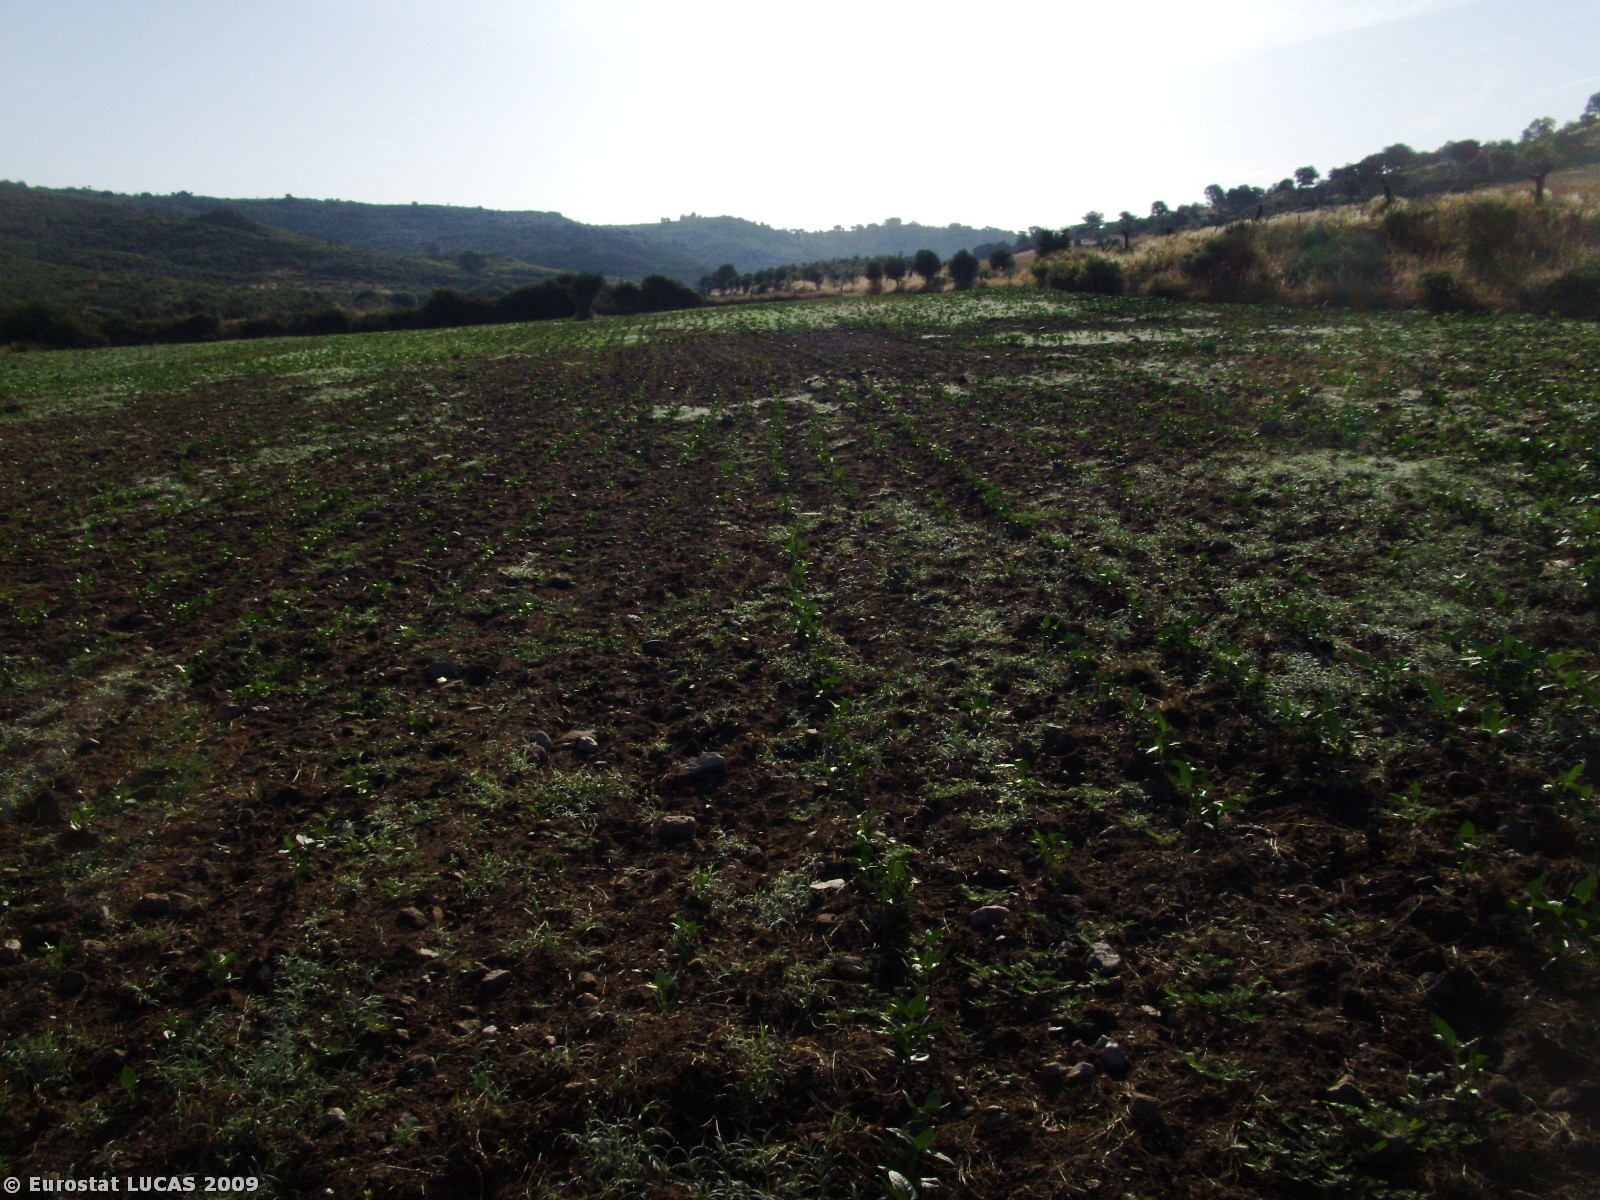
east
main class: Cropland
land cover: Other leguminous and mixtures for fodder
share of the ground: 25 - 50 %
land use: Agriculture (excluding fallow land and kitchen gardens)
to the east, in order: Other leguminous and mixtures for fodder; Shrubland without tree cover; Fences; Tracks; Fences; Olive groves; Rye
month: June
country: PT
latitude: 39.9901
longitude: -7.3017
